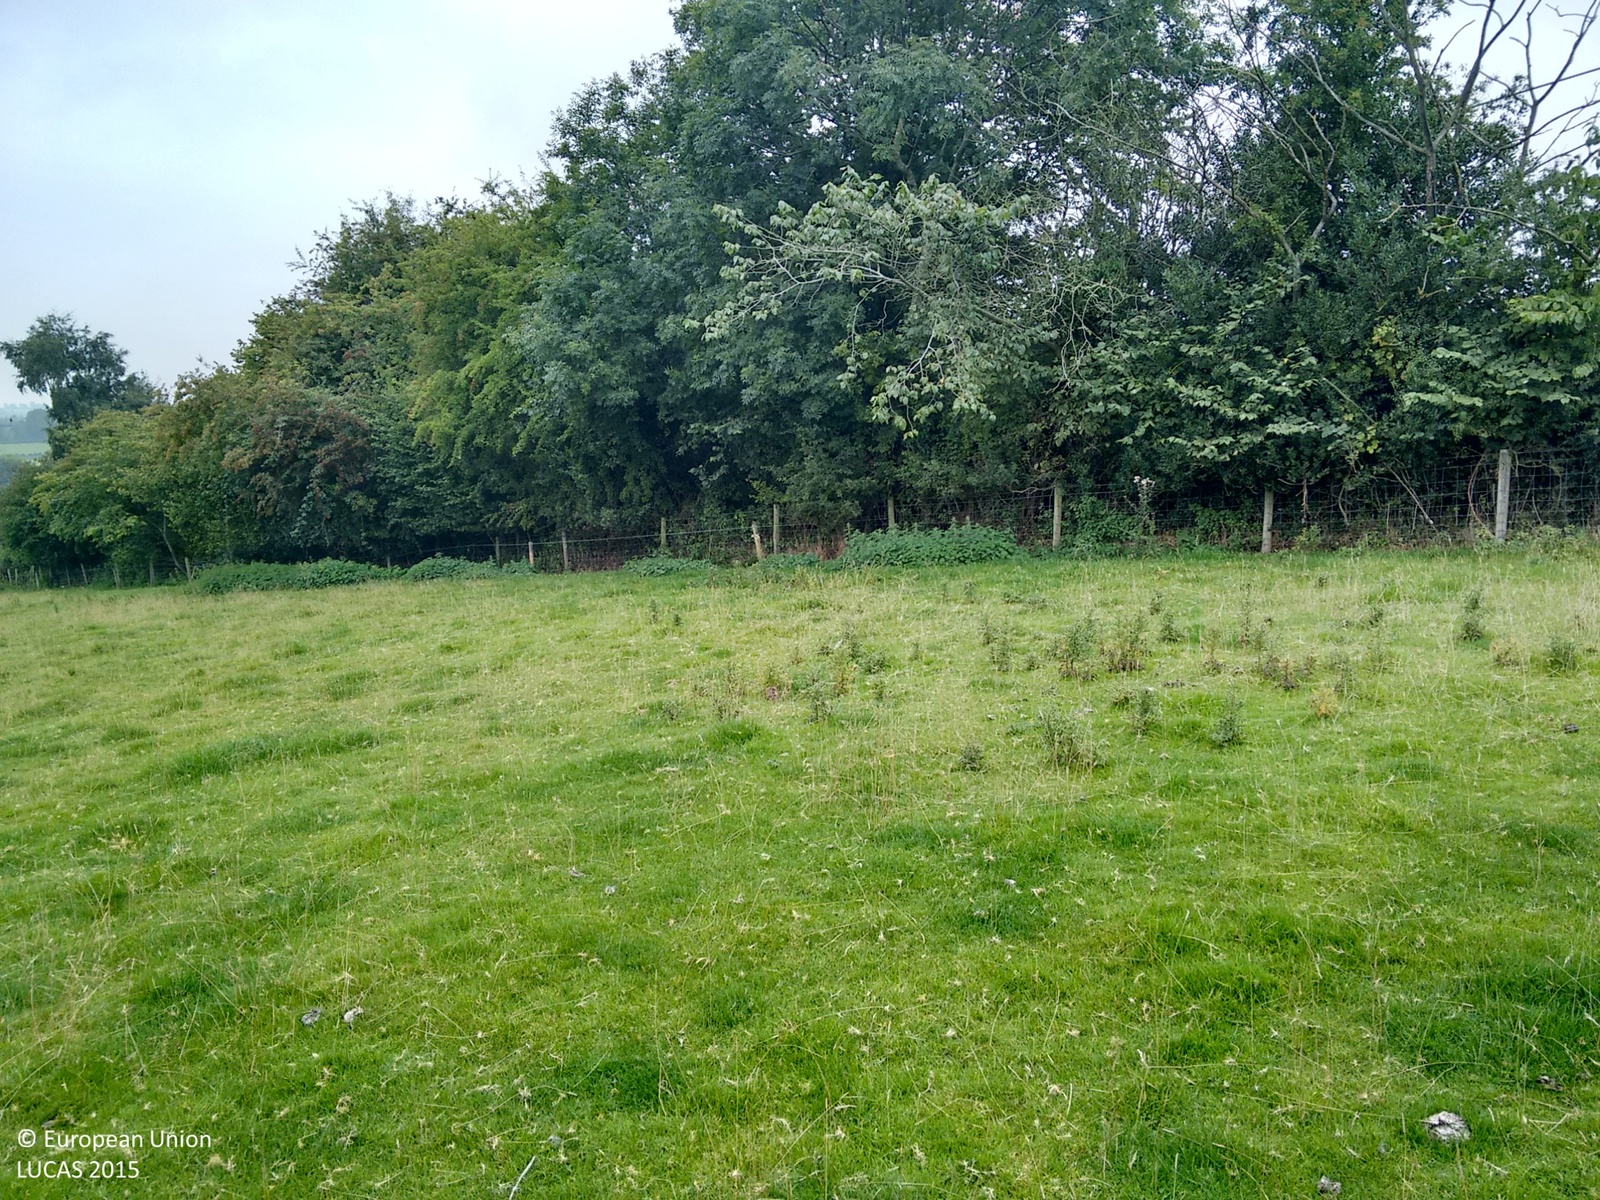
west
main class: Grassland
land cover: Grassland without tree/shrub cover
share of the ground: > 75 %
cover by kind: herbaceous plants 100 %
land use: Agriculture (excluding fallow land and kitchen gardens)
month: September
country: GB
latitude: 52.0983
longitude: -3.1428
